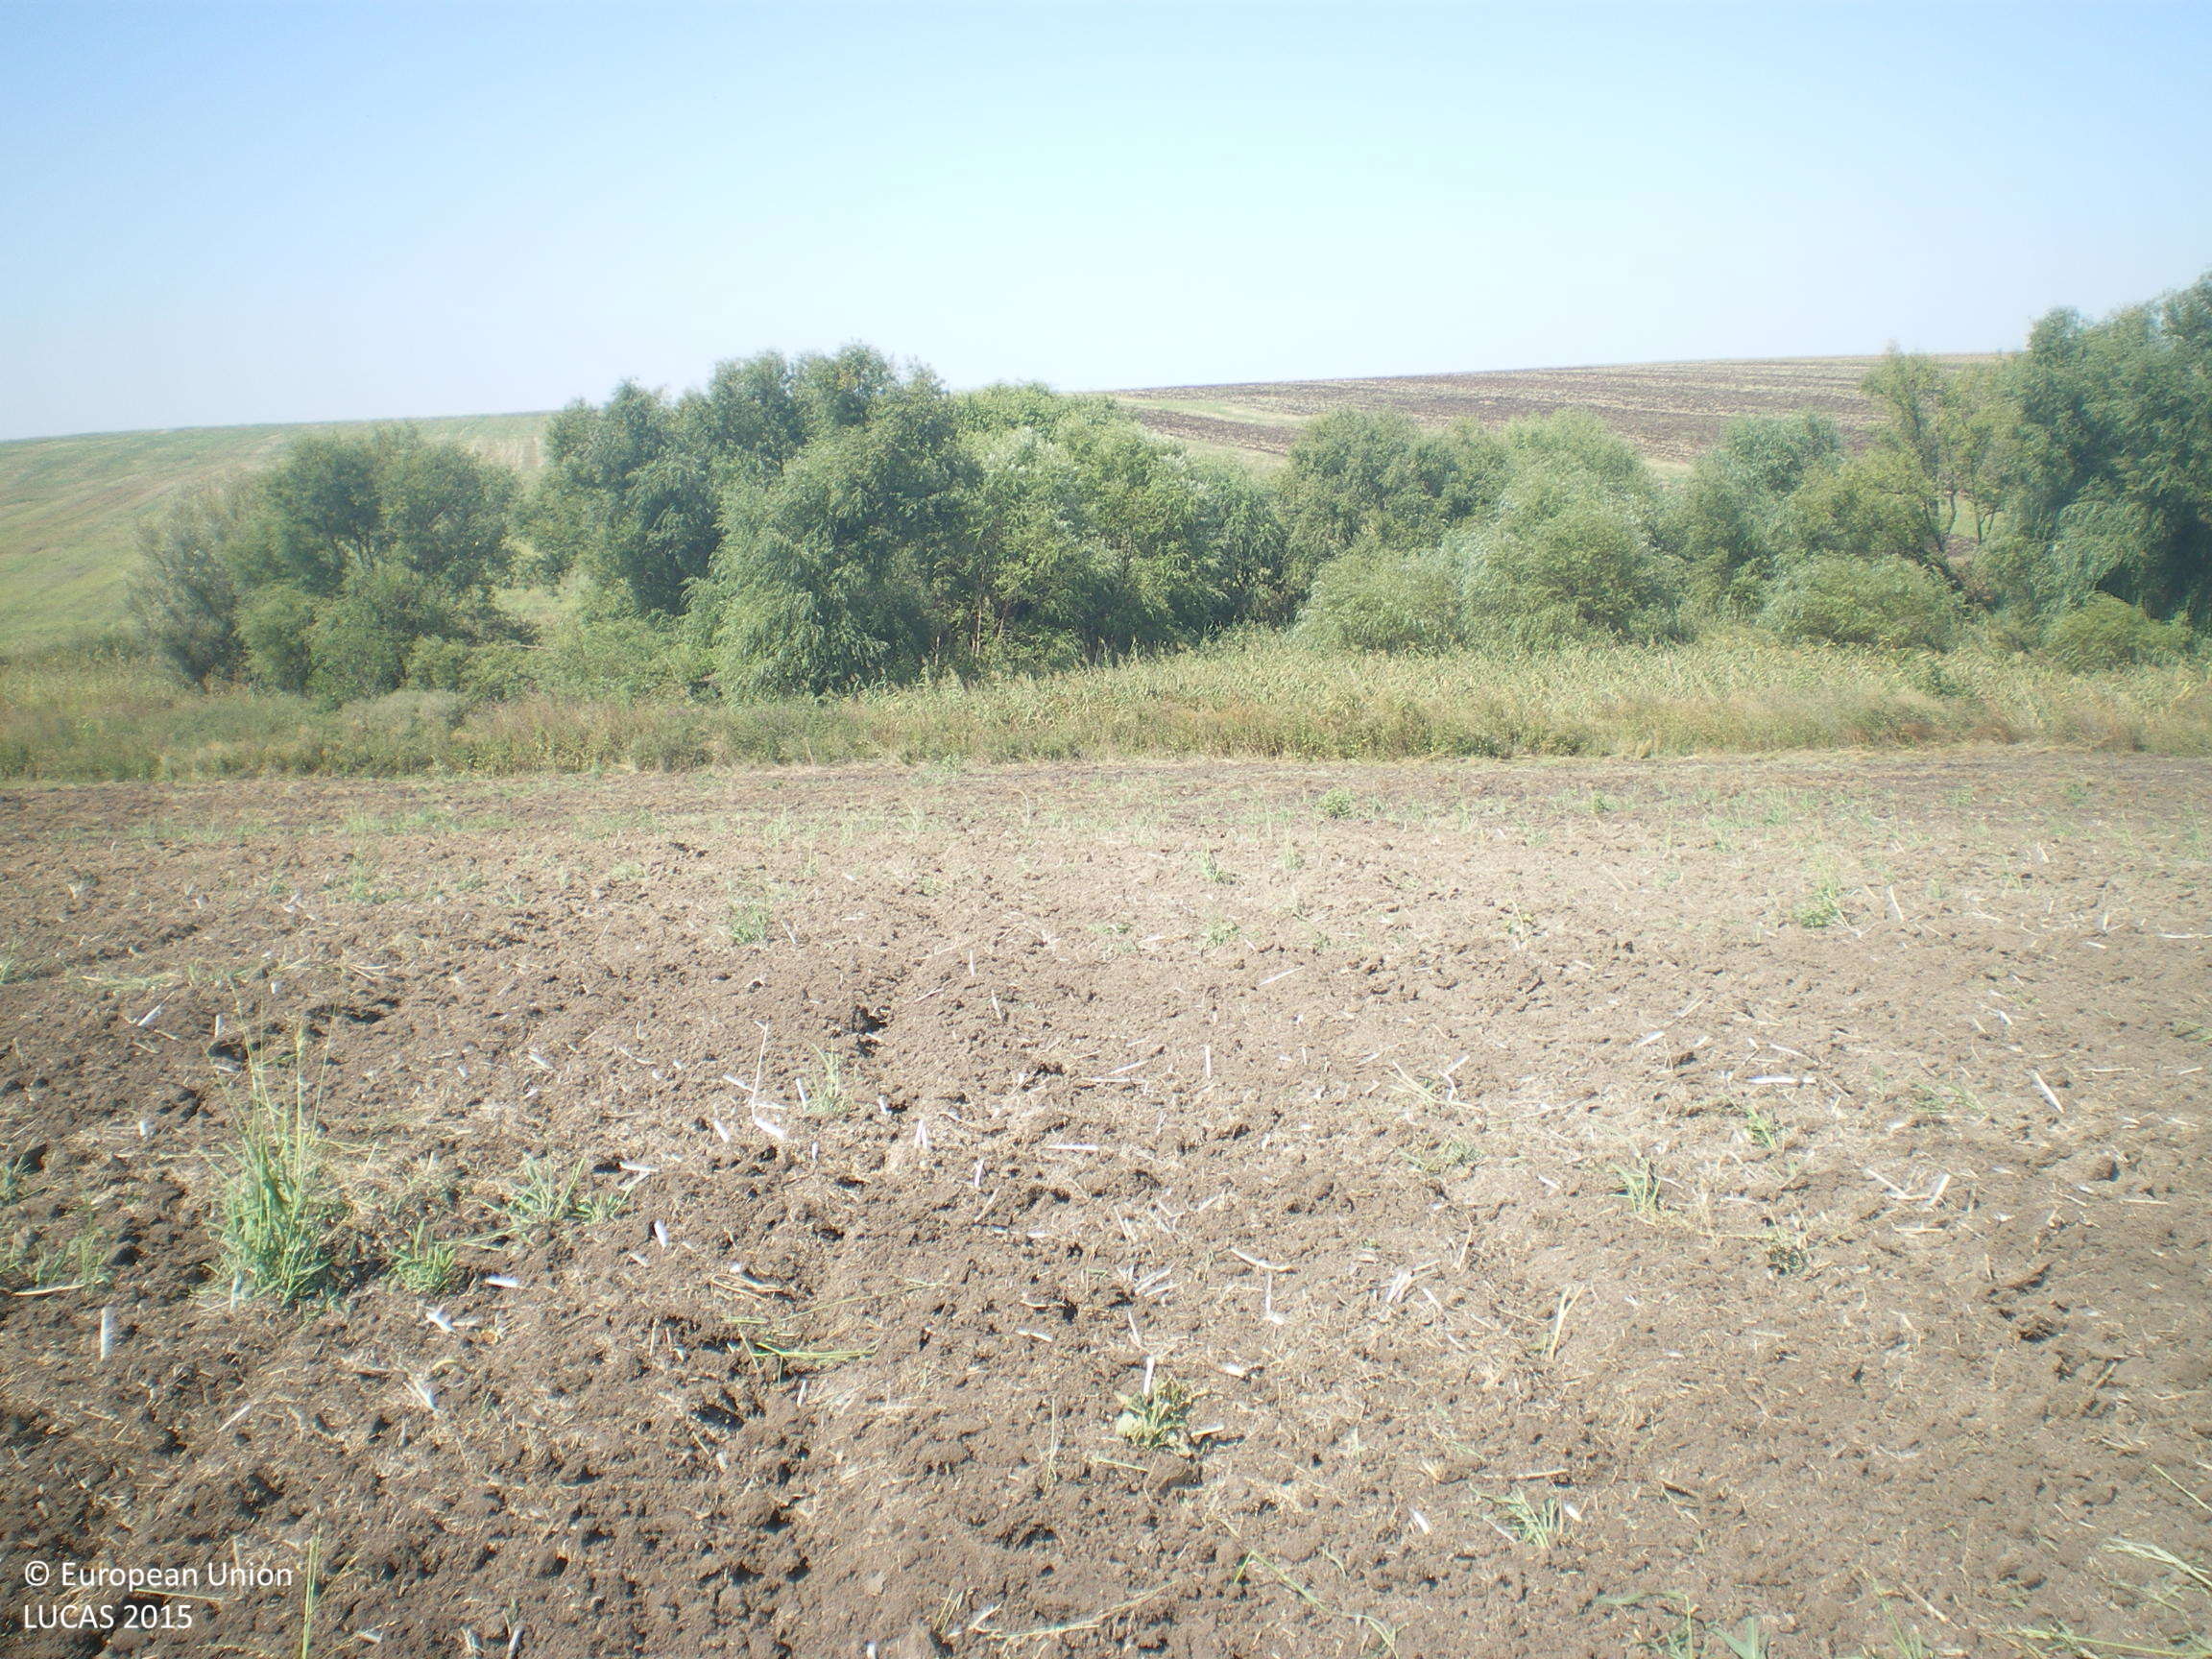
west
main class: Cropland
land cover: Rape and turnip rape
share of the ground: < 10 %
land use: Agriculture (excluding fallow land and kitchen gardens)
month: August
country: BG
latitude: 42.1423
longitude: 25.6658
